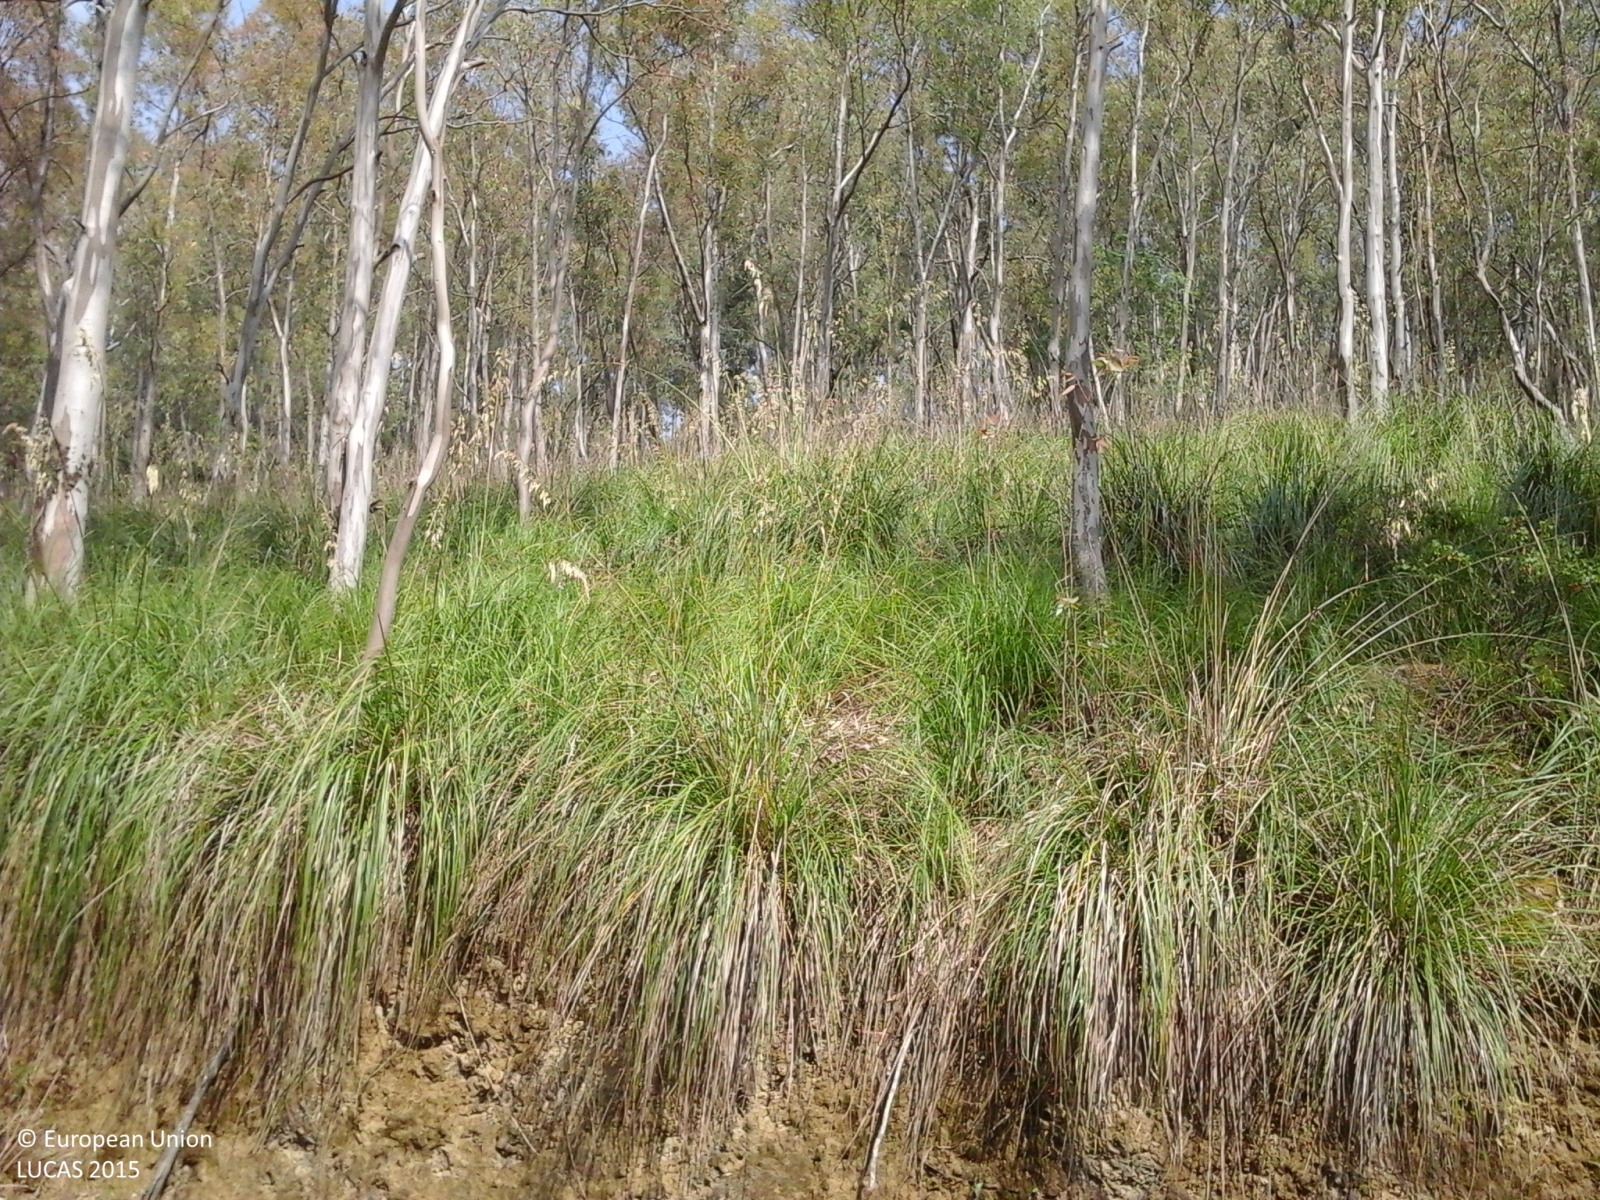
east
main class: Woodland
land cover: Broadleaved woodland
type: thermophilous deciduous forest
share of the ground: > 75 %
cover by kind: broadleaved forest trees 70 %, shrubs 20 %, herbaceous plants 10 %
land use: Forestry
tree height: > 5 m
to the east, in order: Broadleaved woodland; Tracks; Broadleaved woodland
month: June
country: IT
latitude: 37.2629
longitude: 14.4202
